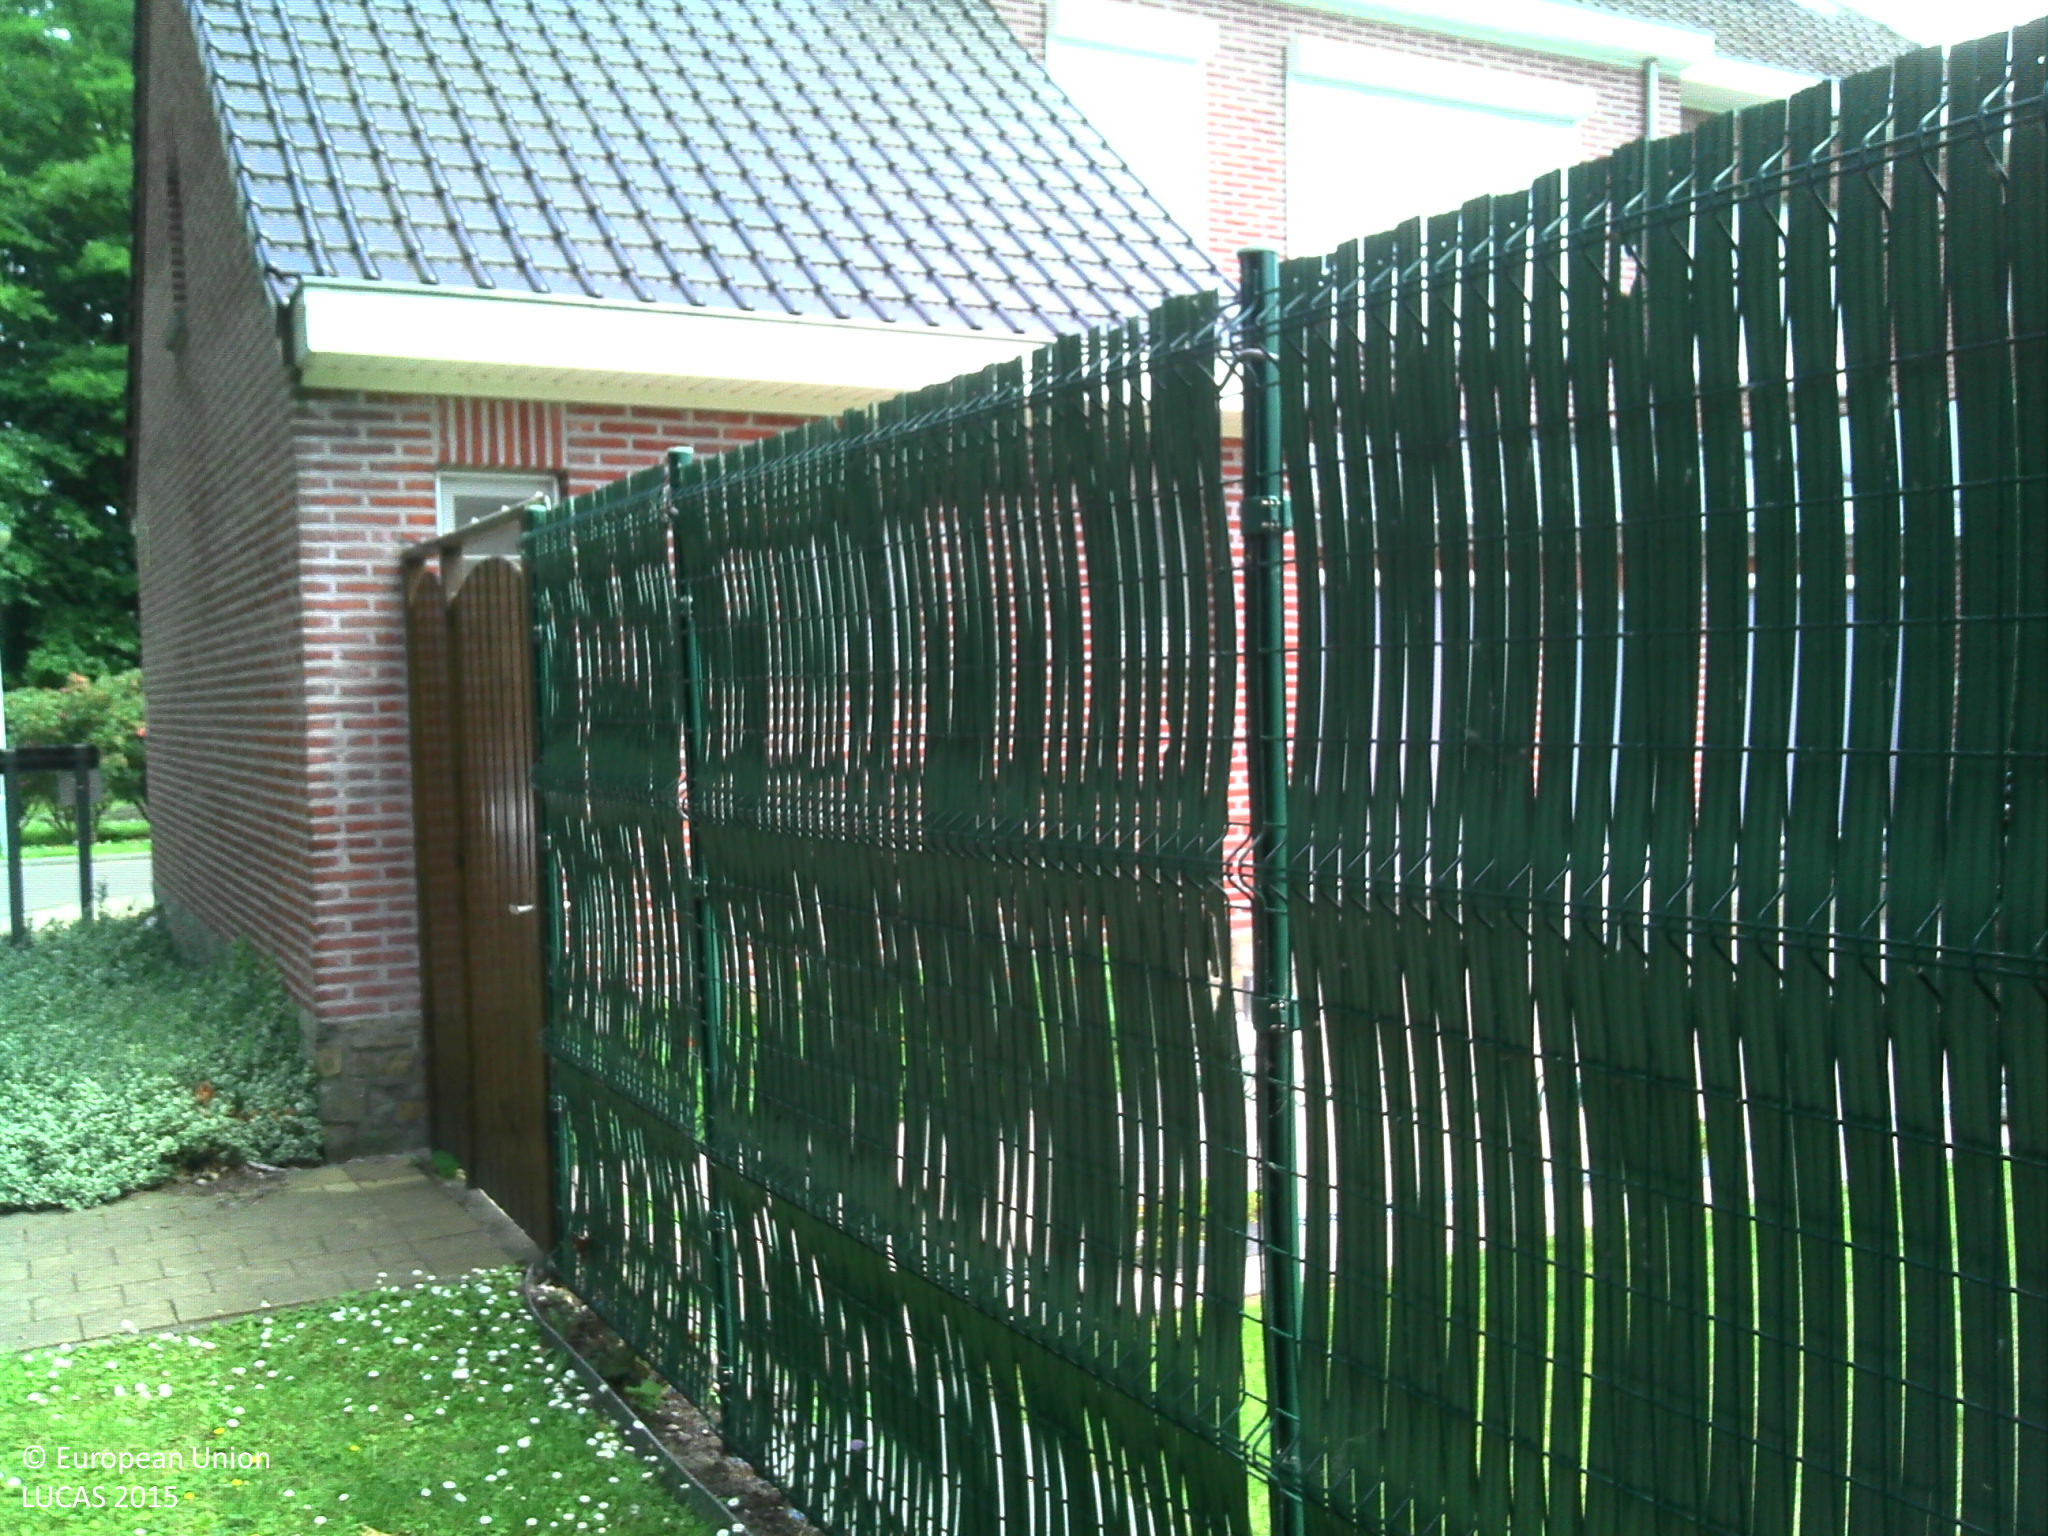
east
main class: Grassland
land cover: Grassland without tree/shrub cover
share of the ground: > 75 %
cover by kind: herbaceous plants 100 %
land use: Residential
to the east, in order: Grassland without tree/shrub cover; Artificial constructions in urban areas
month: June
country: BE
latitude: 51.2111
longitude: 4.2547
